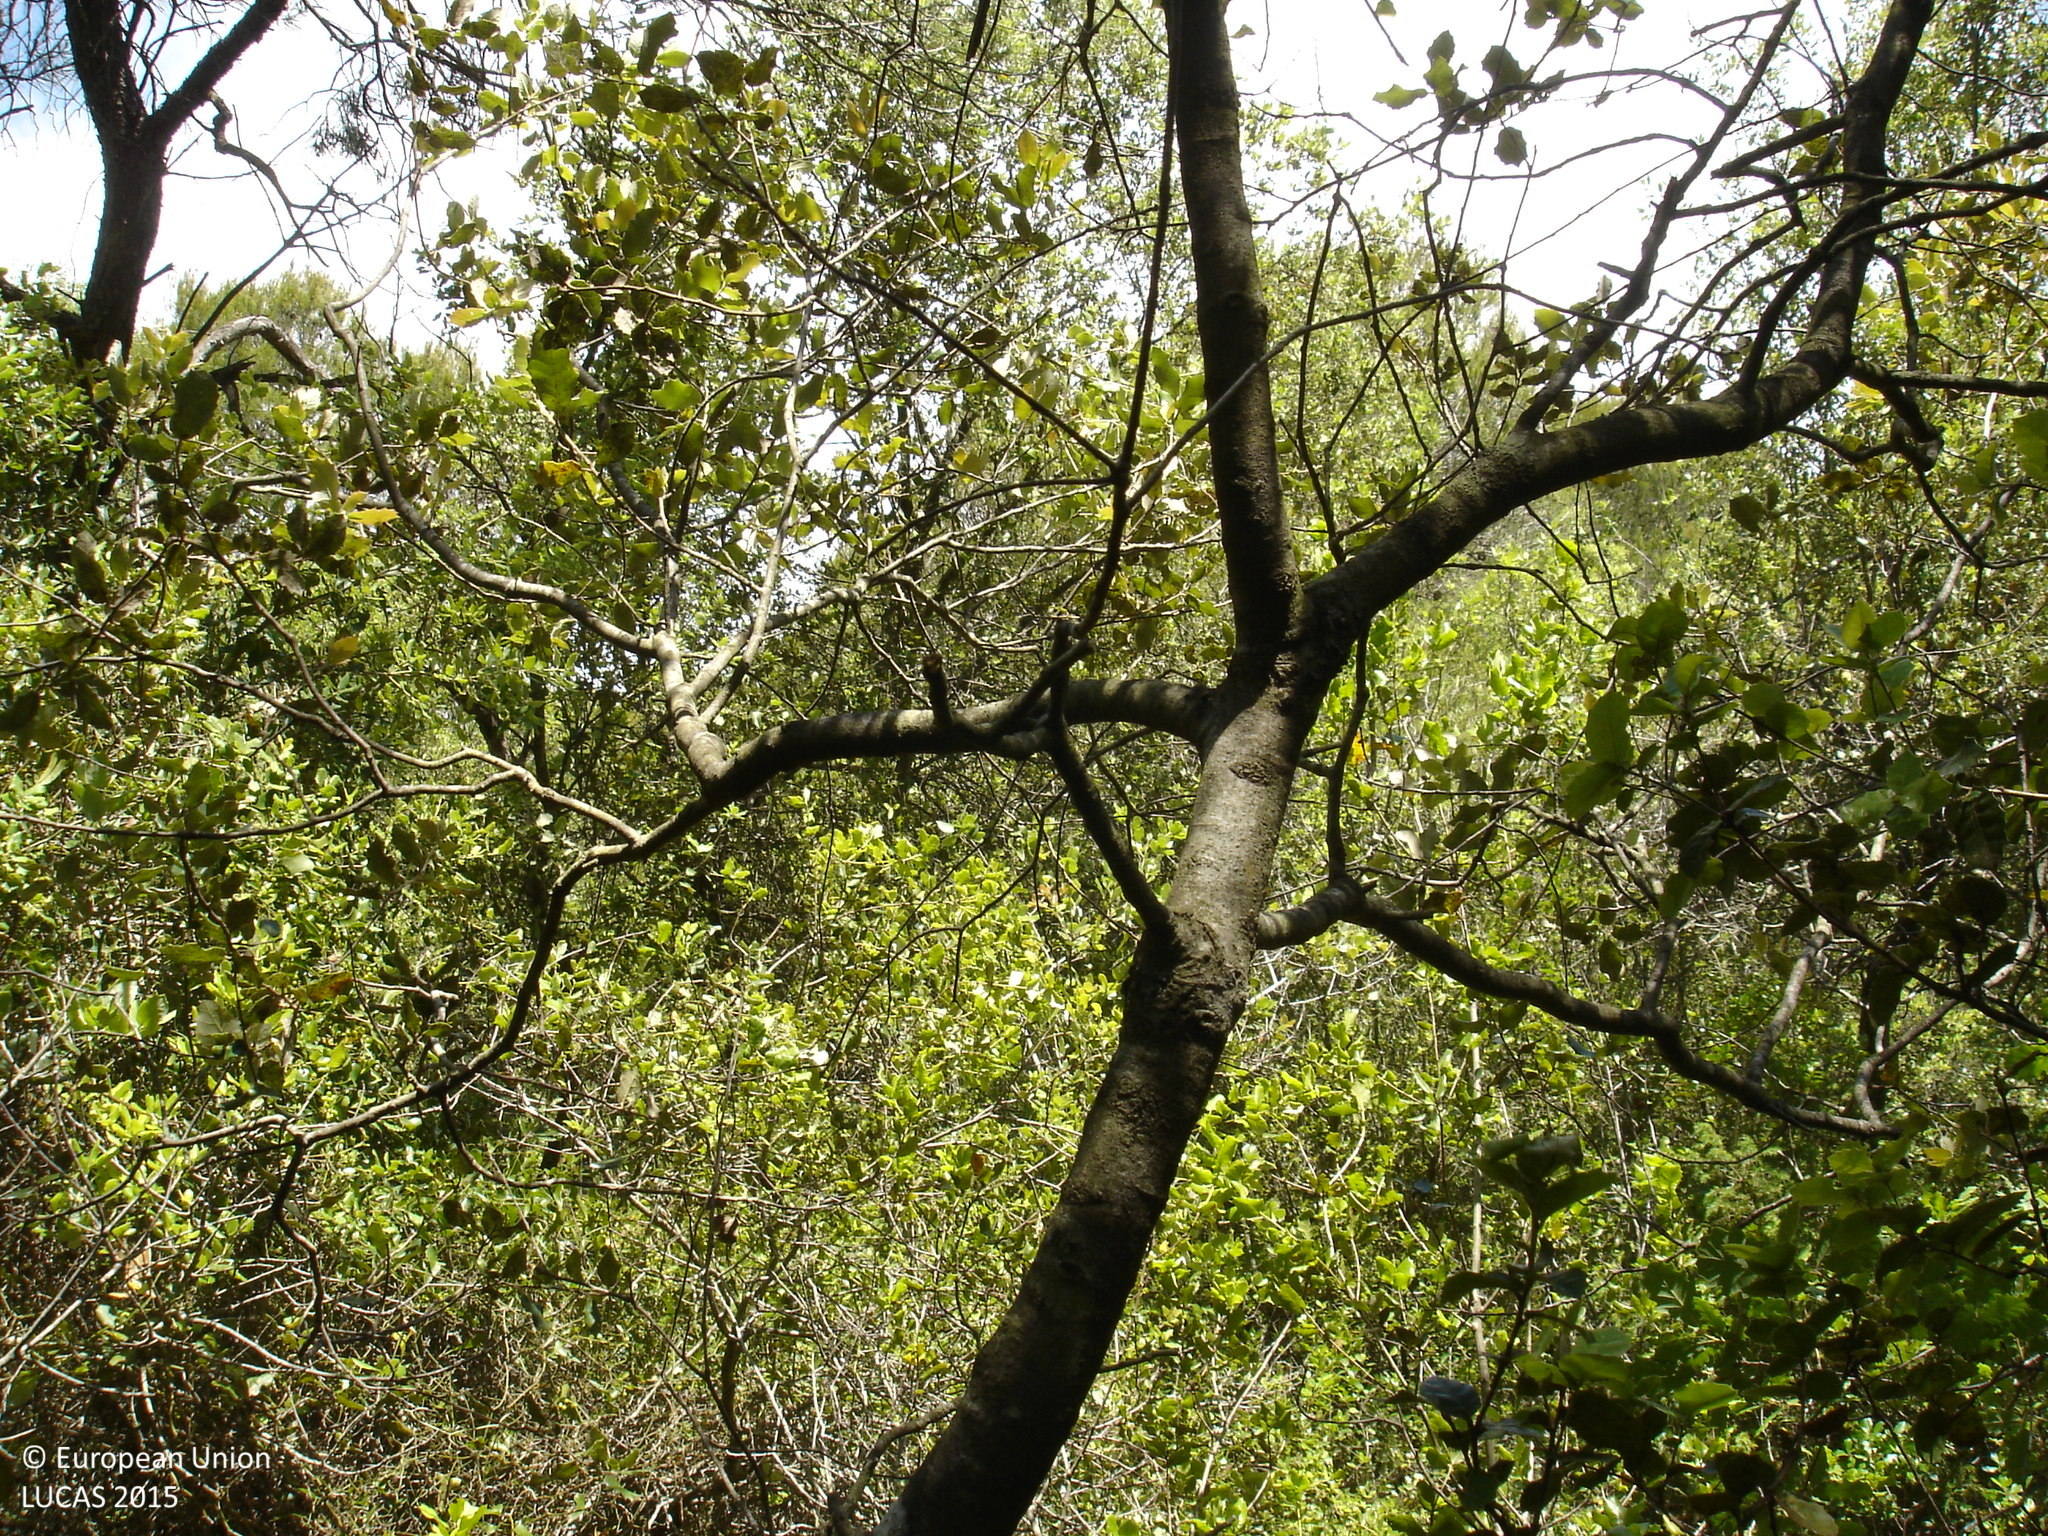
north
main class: Woodland
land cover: Other mixed woodland
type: coniferous forest of the mediterranean region
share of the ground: > 75 %
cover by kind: coniferous forest trees 50 %, broadleaved forest trees 40 %, shrubs 10 %
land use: Forestry
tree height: > 5 m
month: May
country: ES
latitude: 42.1208
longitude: 2.9874
